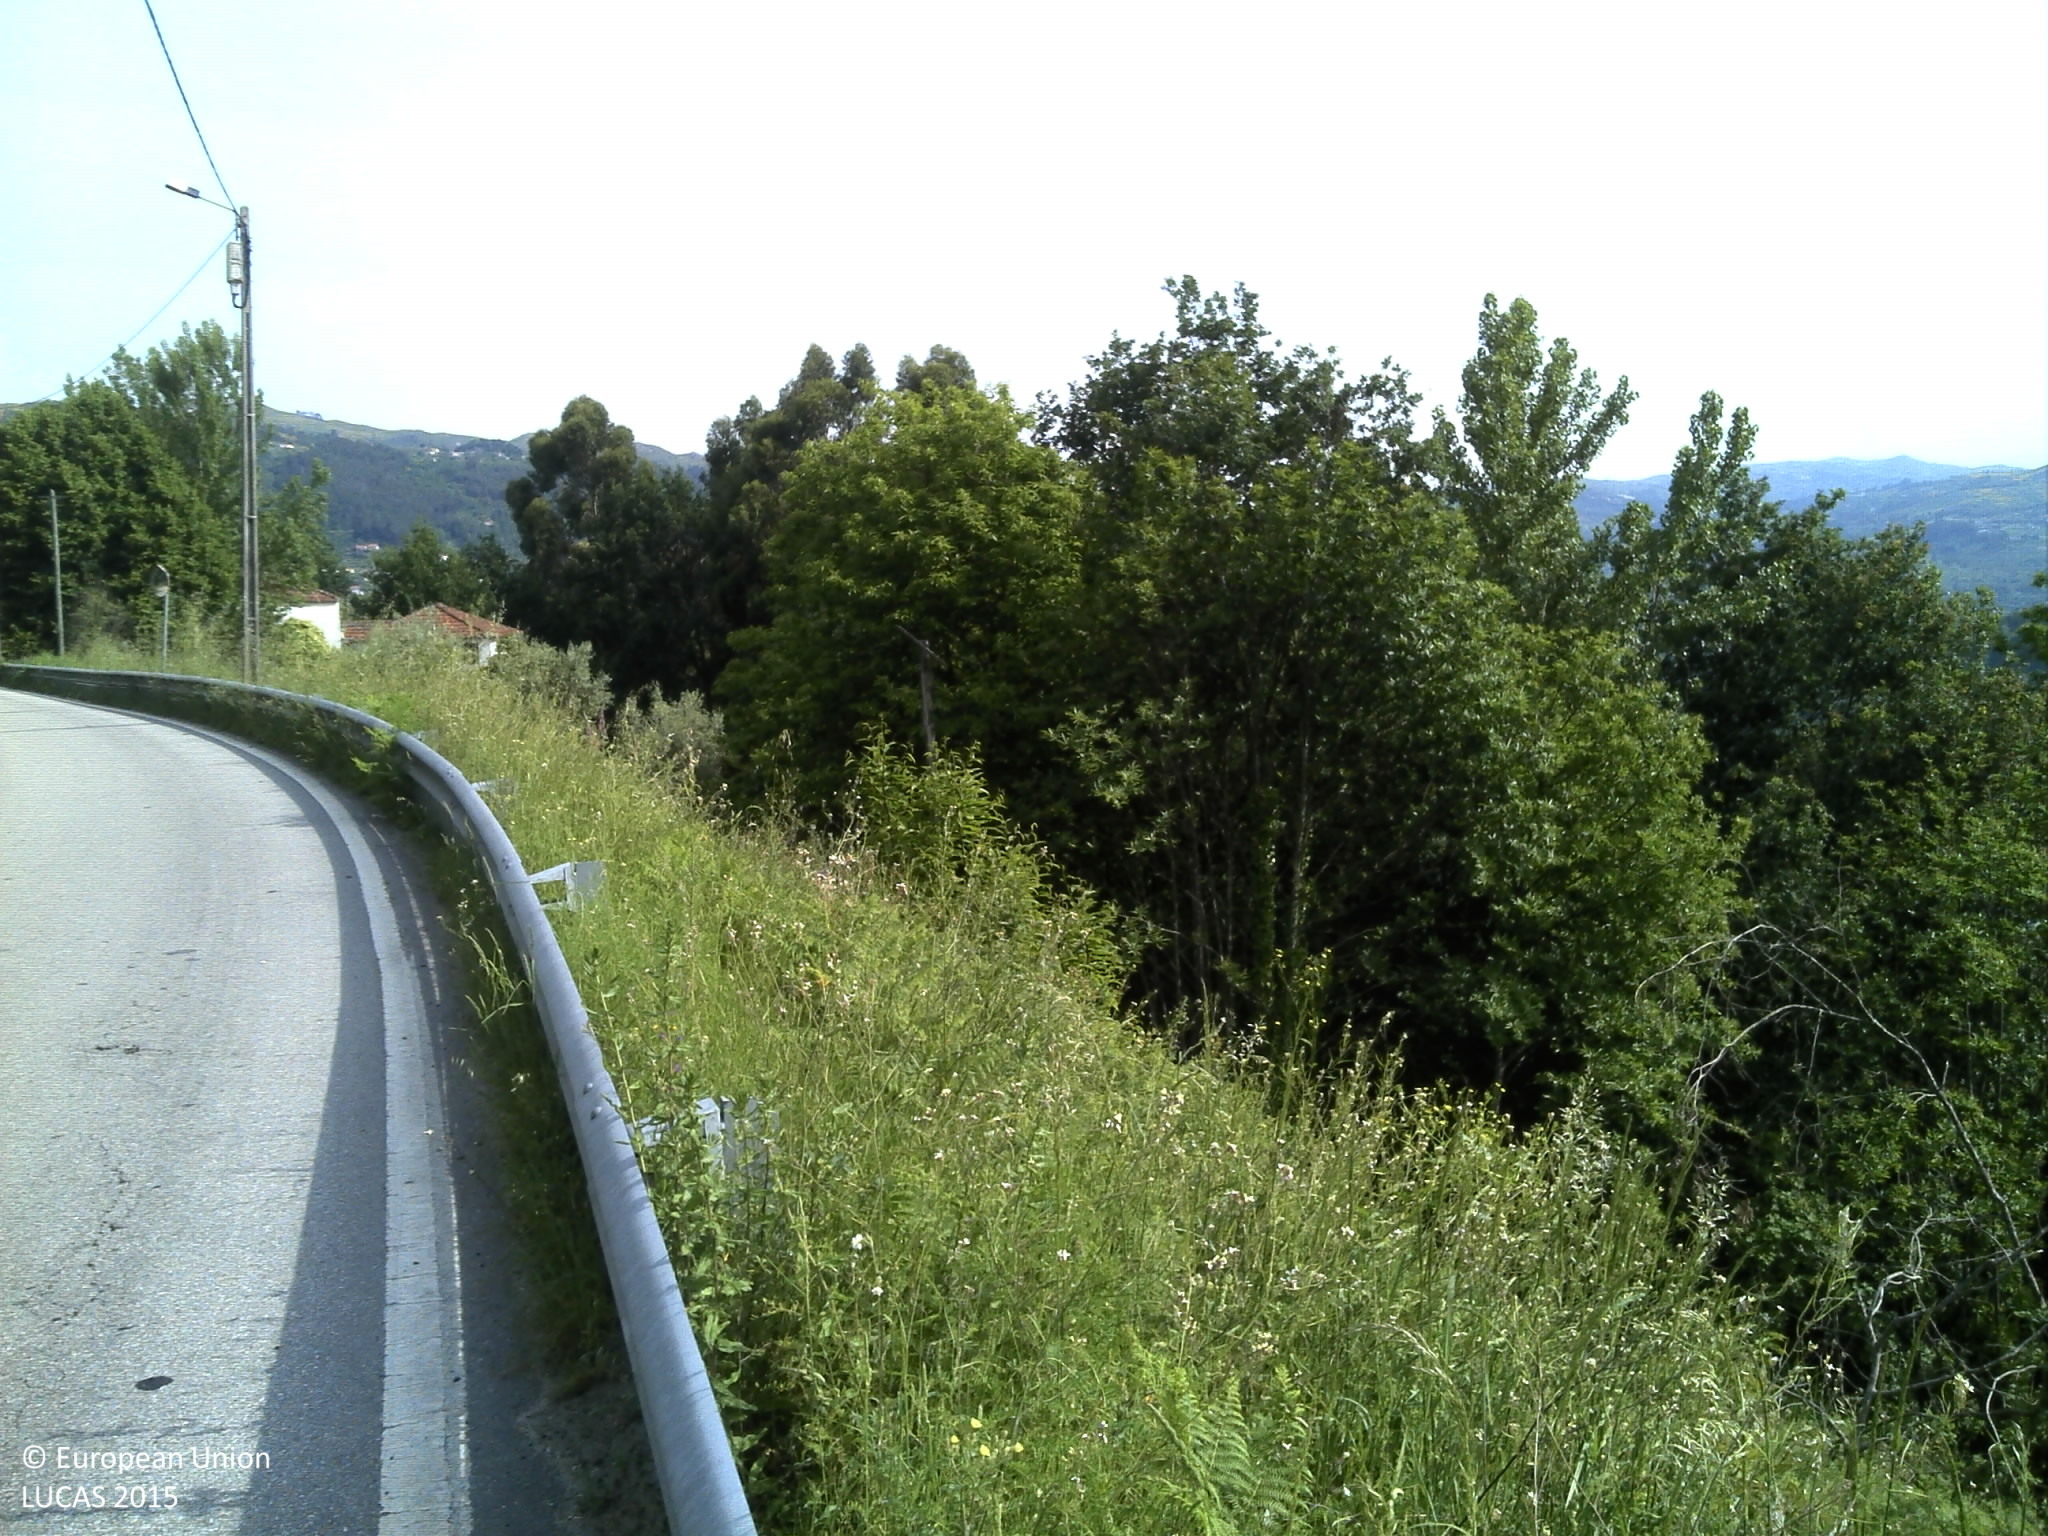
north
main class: Woodland
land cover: Broadleaved woodland
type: thermophilous deciduous forest
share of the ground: > 75 %
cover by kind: broadleaved forest trees 85 %, shrubs 5 %, herbaceous plants 5 %, unconsolidated bare surface 5 %
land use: Forestry
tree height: > 5 m
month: May
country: PT
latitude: 41.0770
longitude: -8.1217
